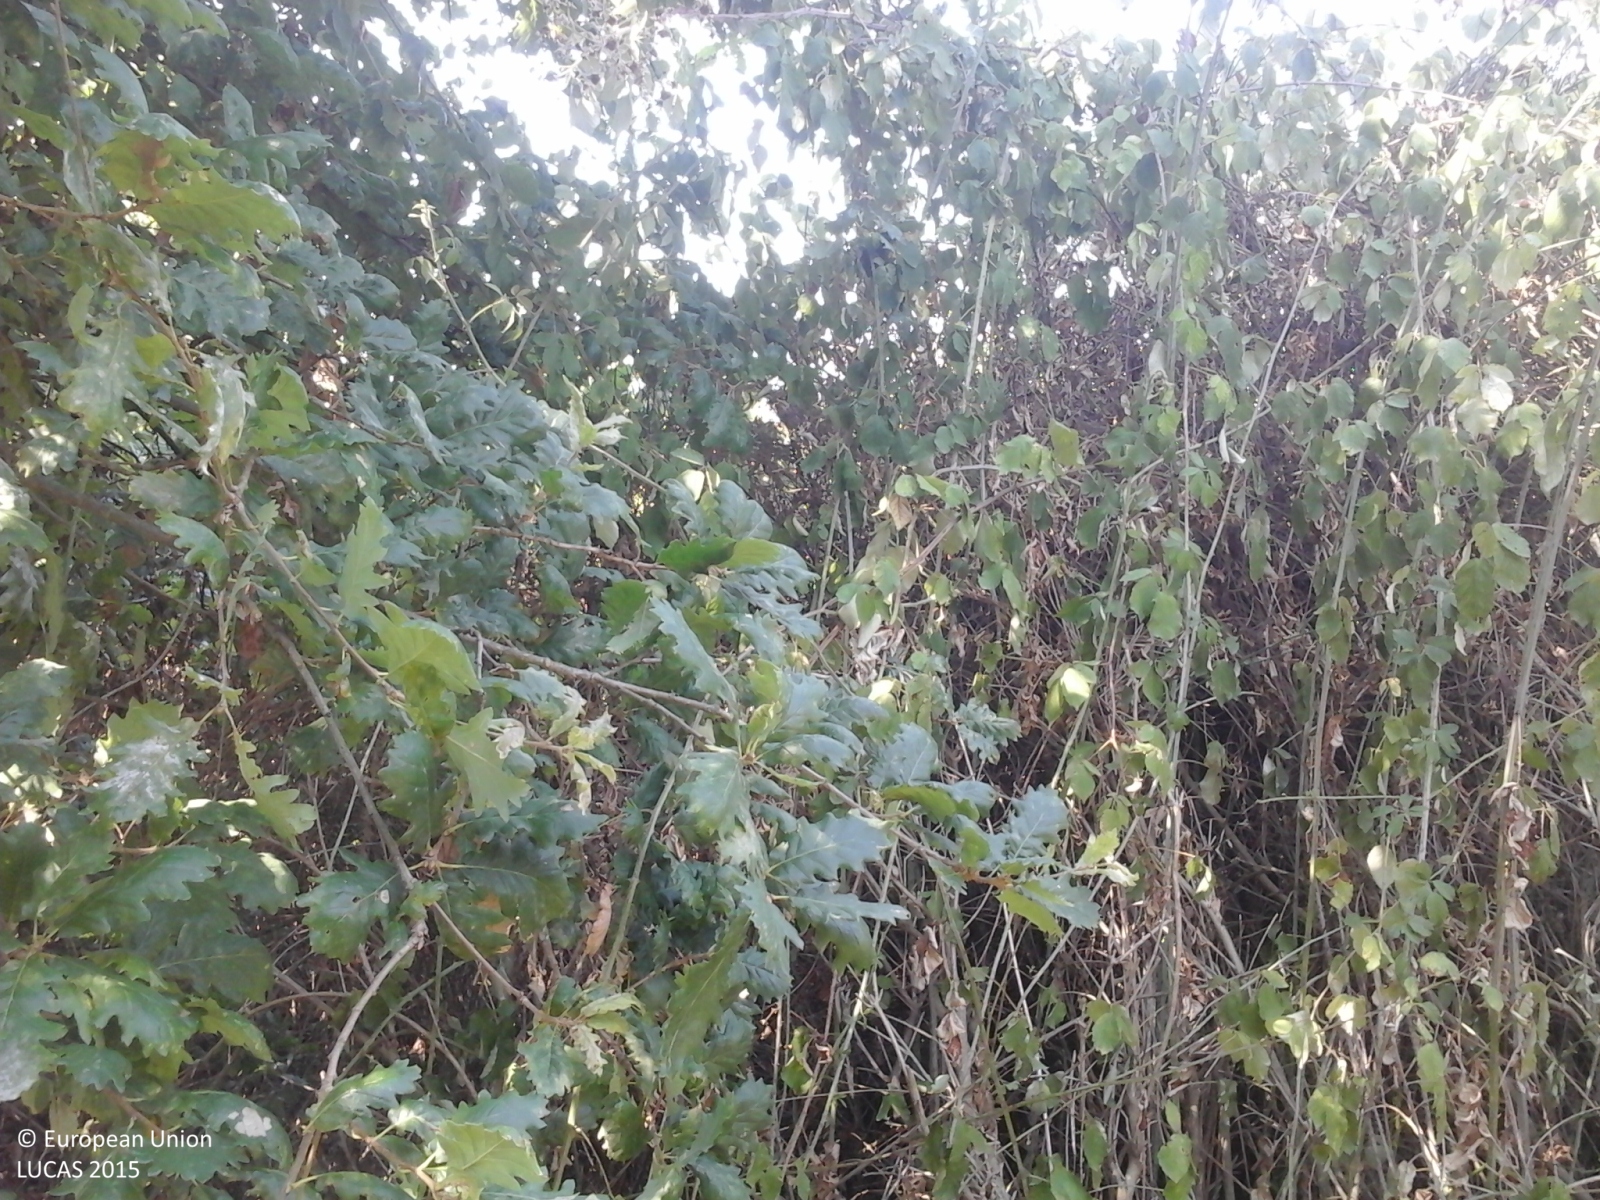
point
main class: Shrubland
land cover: Shrubland without tree cover
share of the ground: > 75 %
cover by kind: shrubs 100 %
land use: Abandoned areas
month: August
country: IT
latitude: 43.8978
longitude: 10.6085
